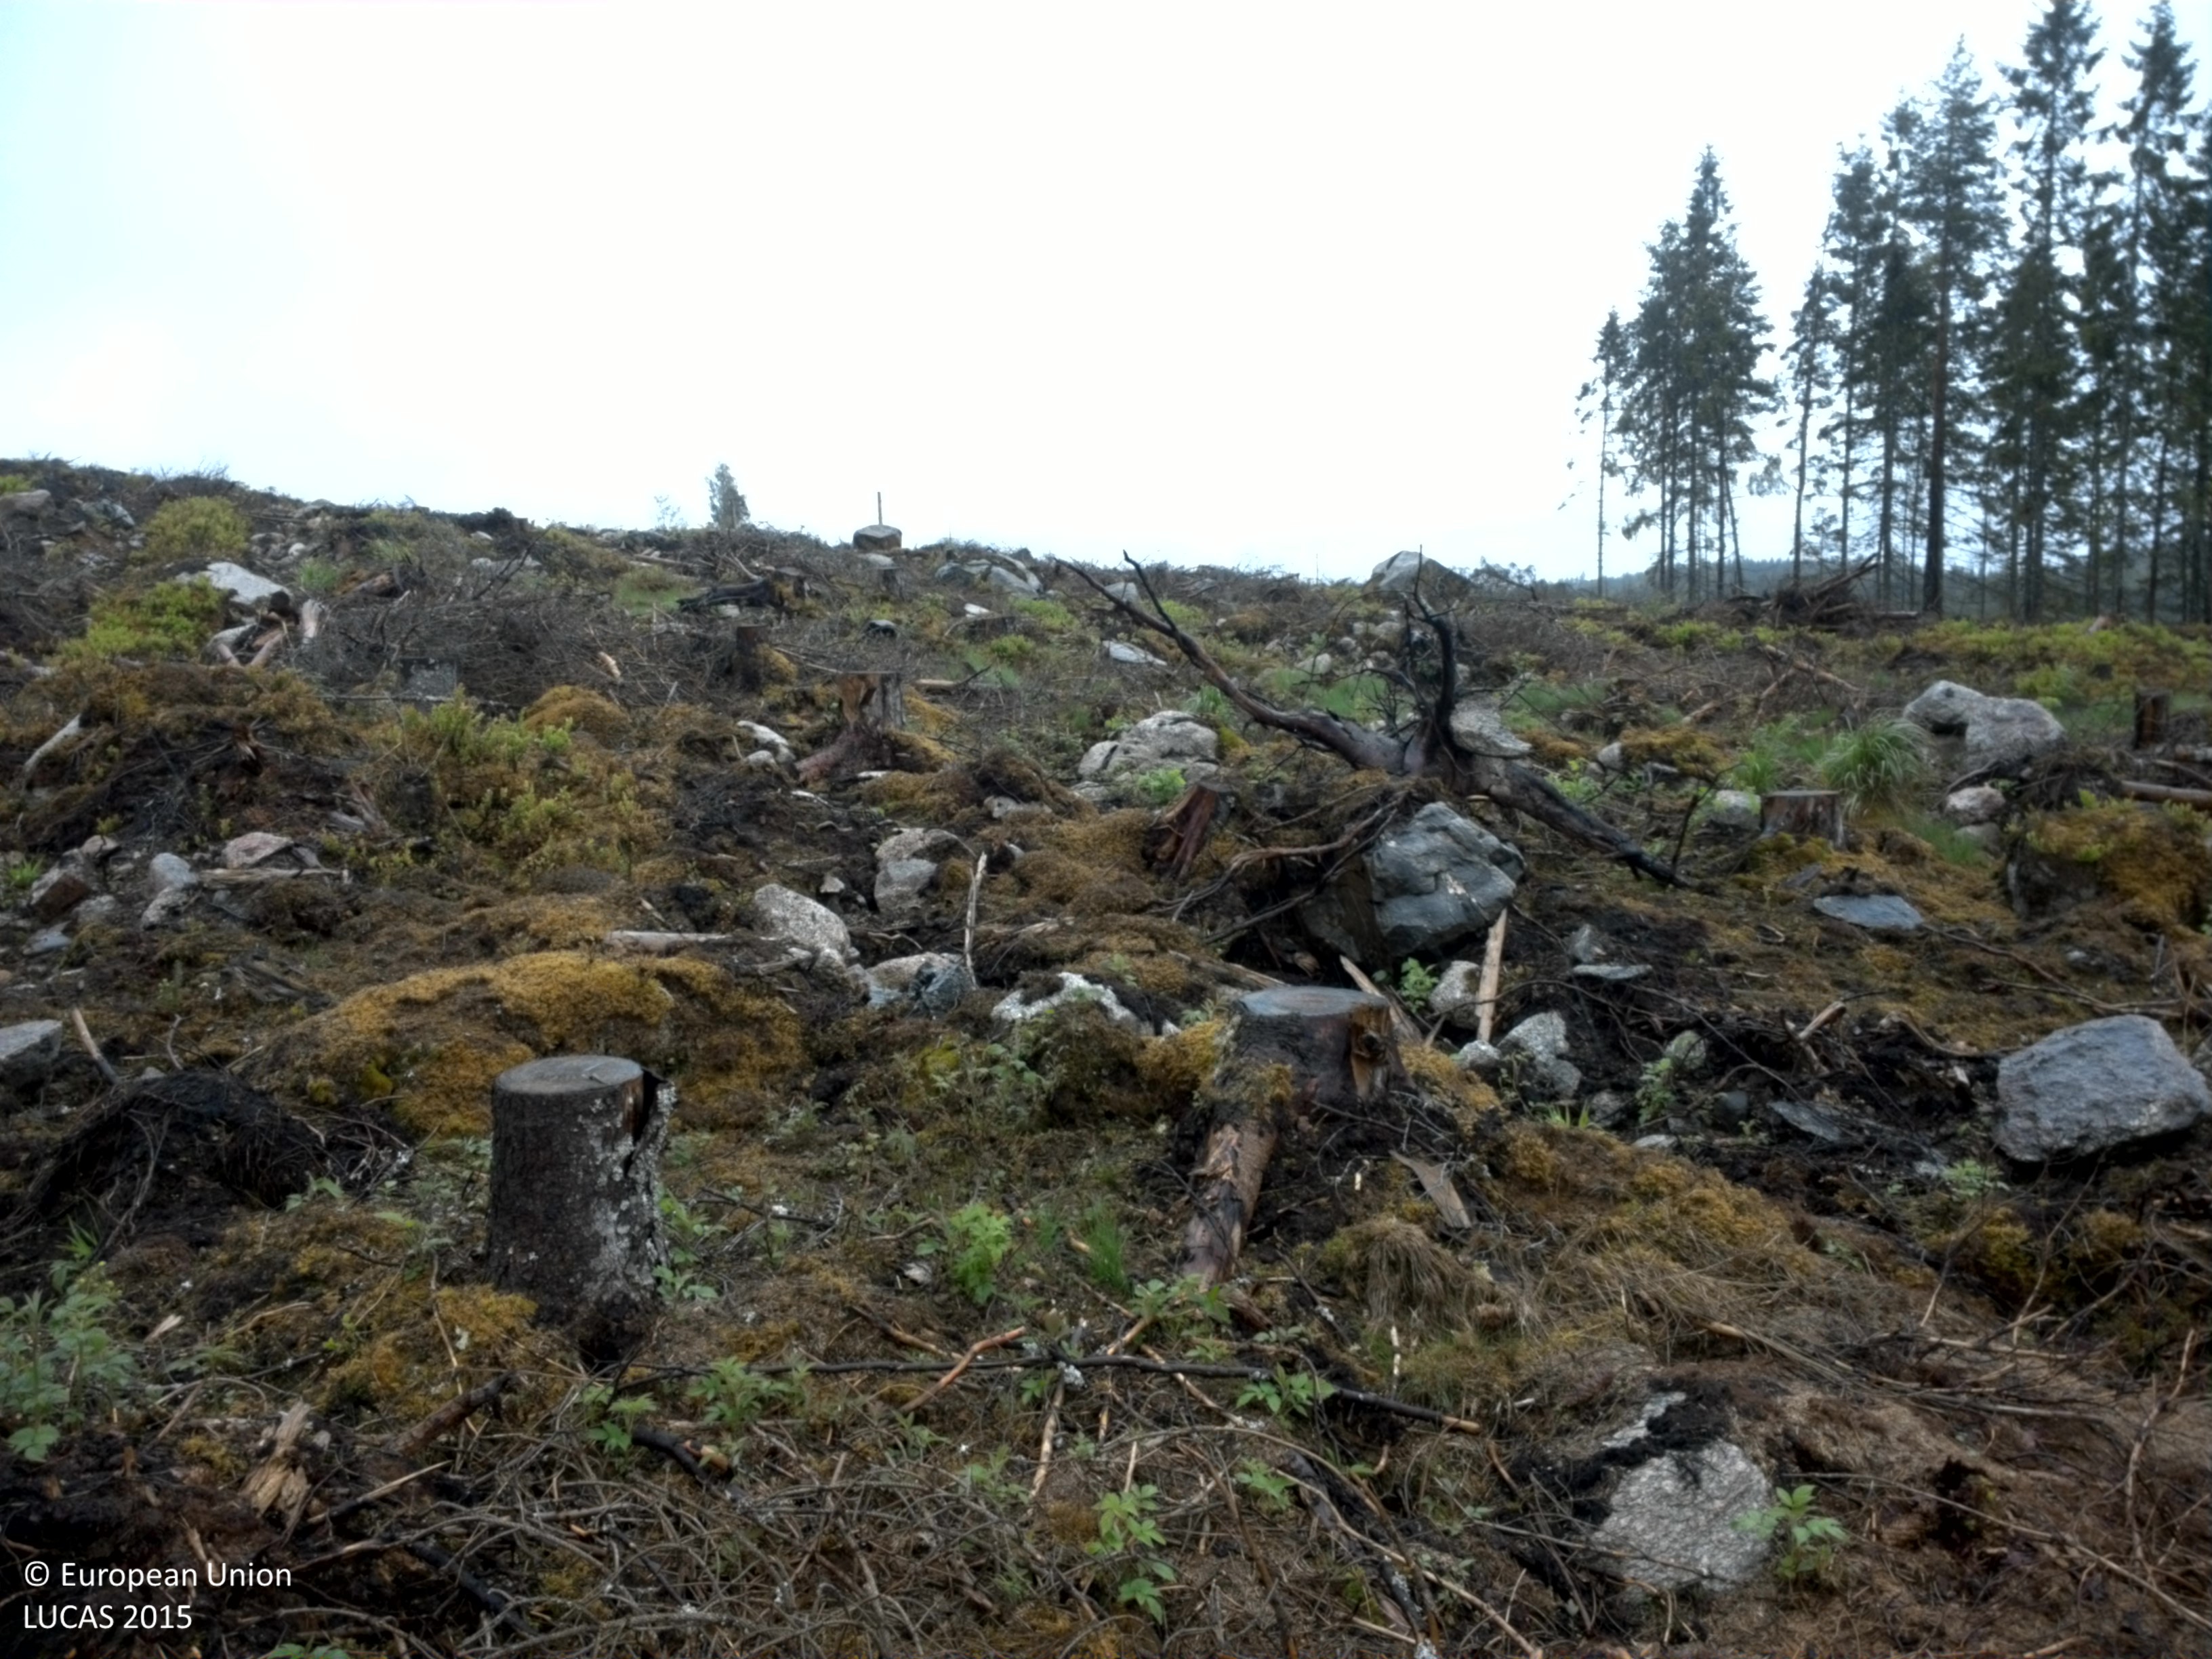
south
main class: Woodland
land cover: Broadleaved woodland
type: boreal forest
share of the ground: 10 - 25 %
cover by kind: shrubs 35 %, herbaceous plants 35 %, broadleaved forest trees 10 %, lichens and mosses 10 %, consolidated bare surface 10 %
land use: Forestry
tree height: < 5 m
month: May
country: SE
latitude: 59.4521
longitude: 14.1718
